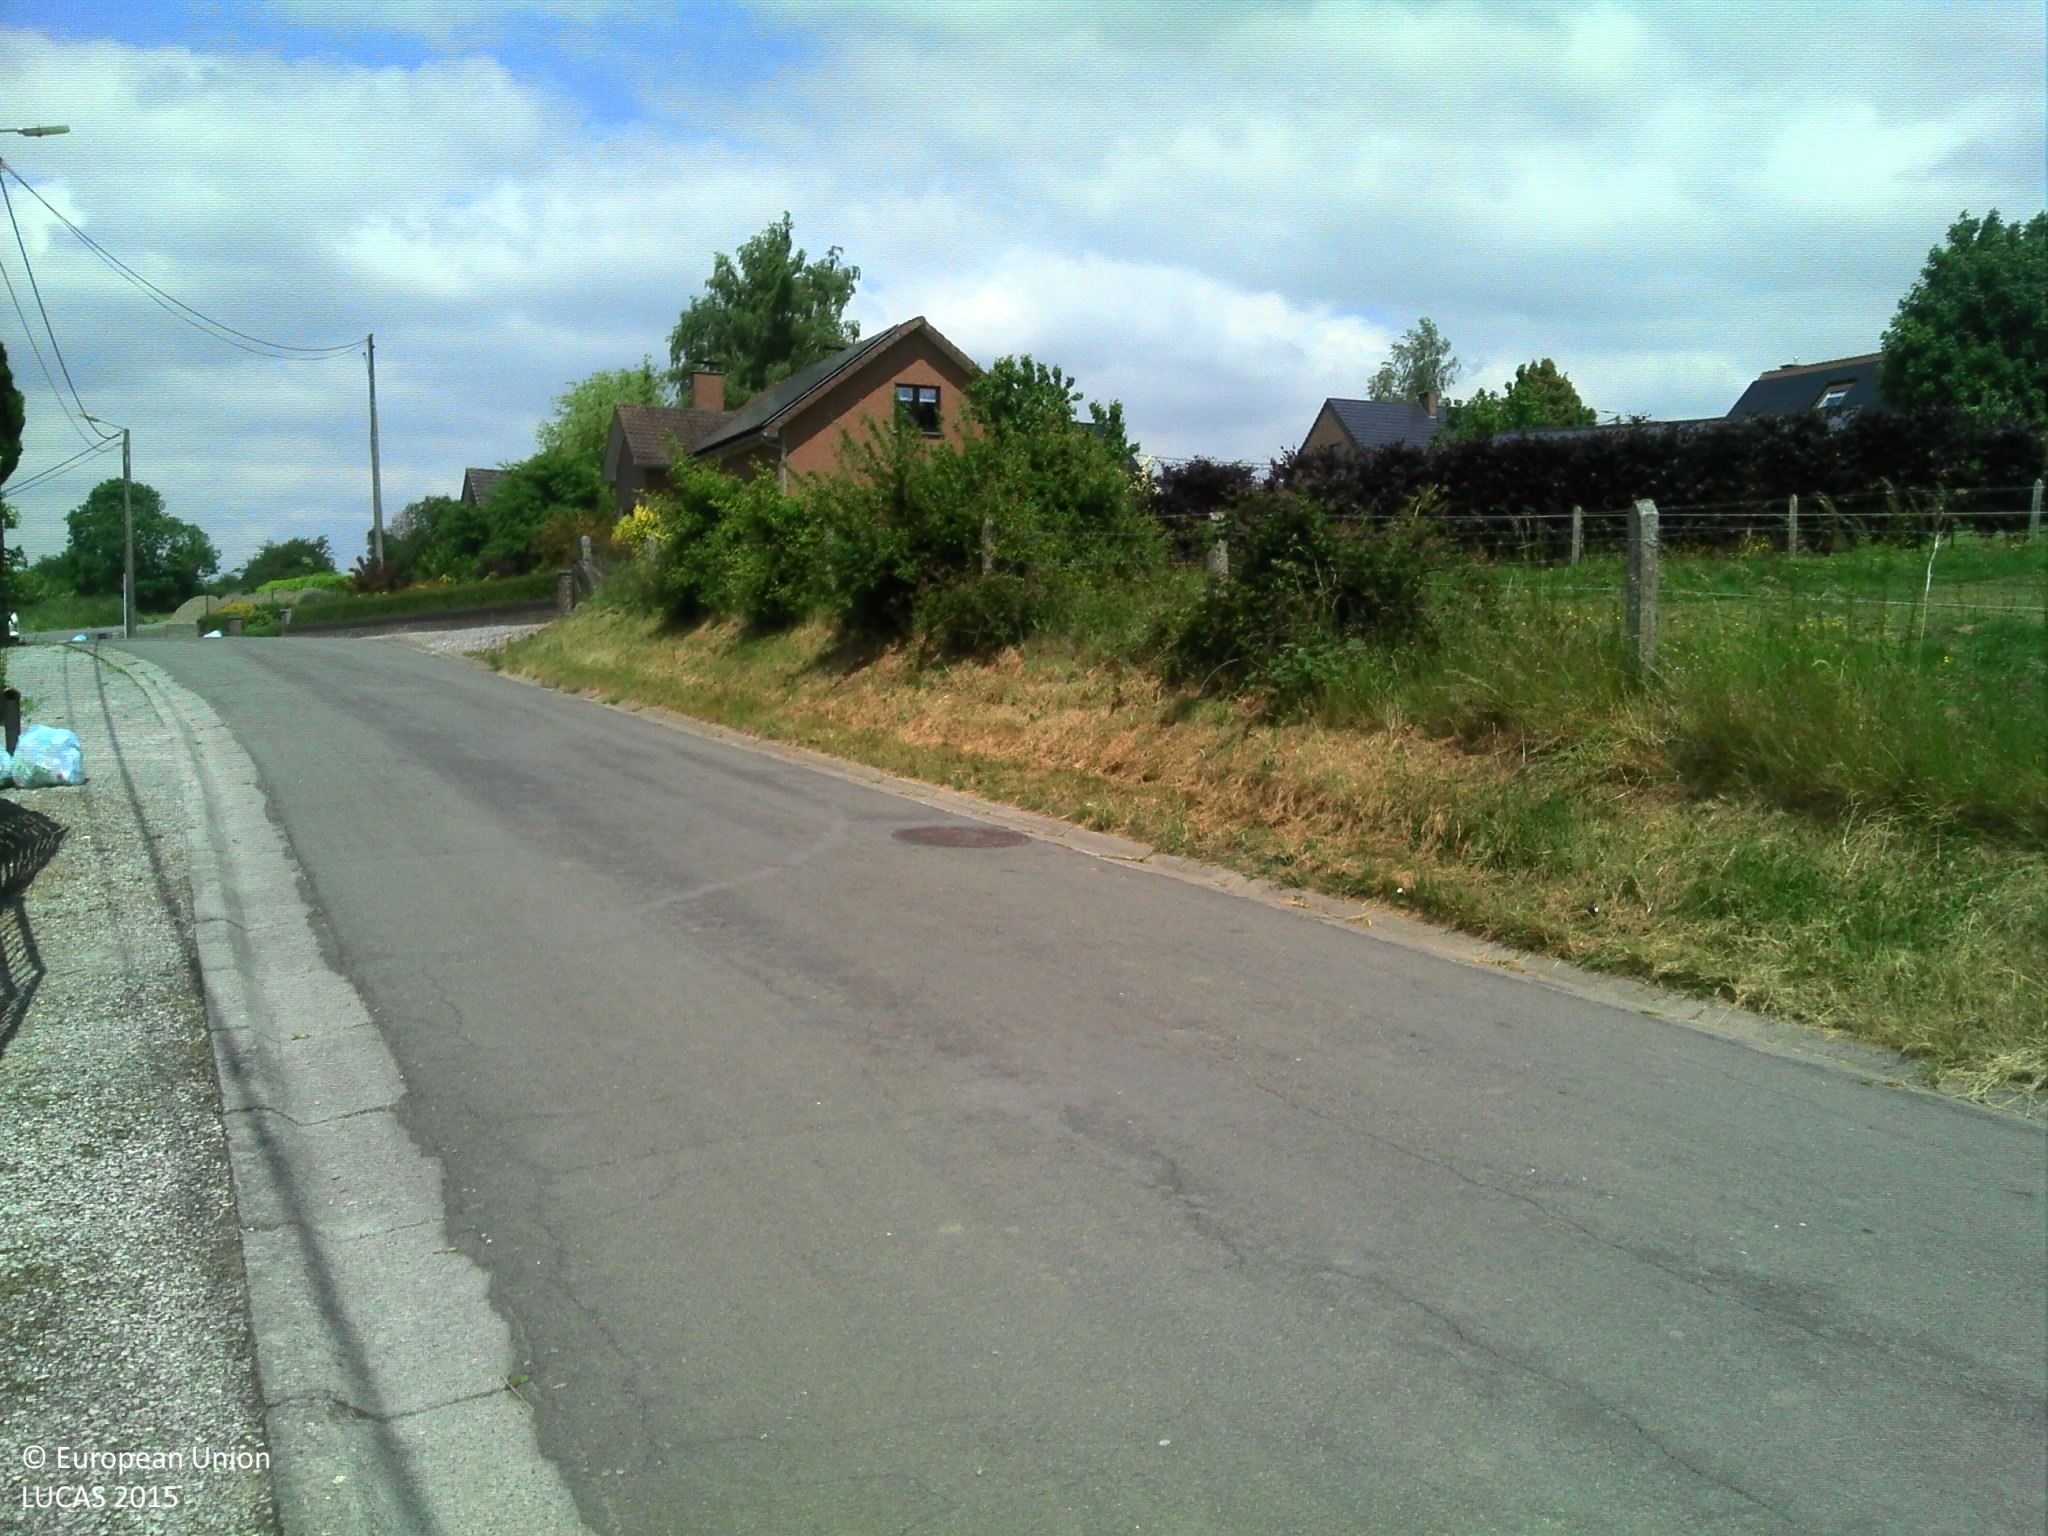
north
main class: Grassland
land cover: Grassland without tree/shrub cover
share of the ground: > 75 %
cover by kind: herbaceous plants 100 %
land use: Residential
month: June
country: BE
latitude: 50.3454
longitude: 4.6142
